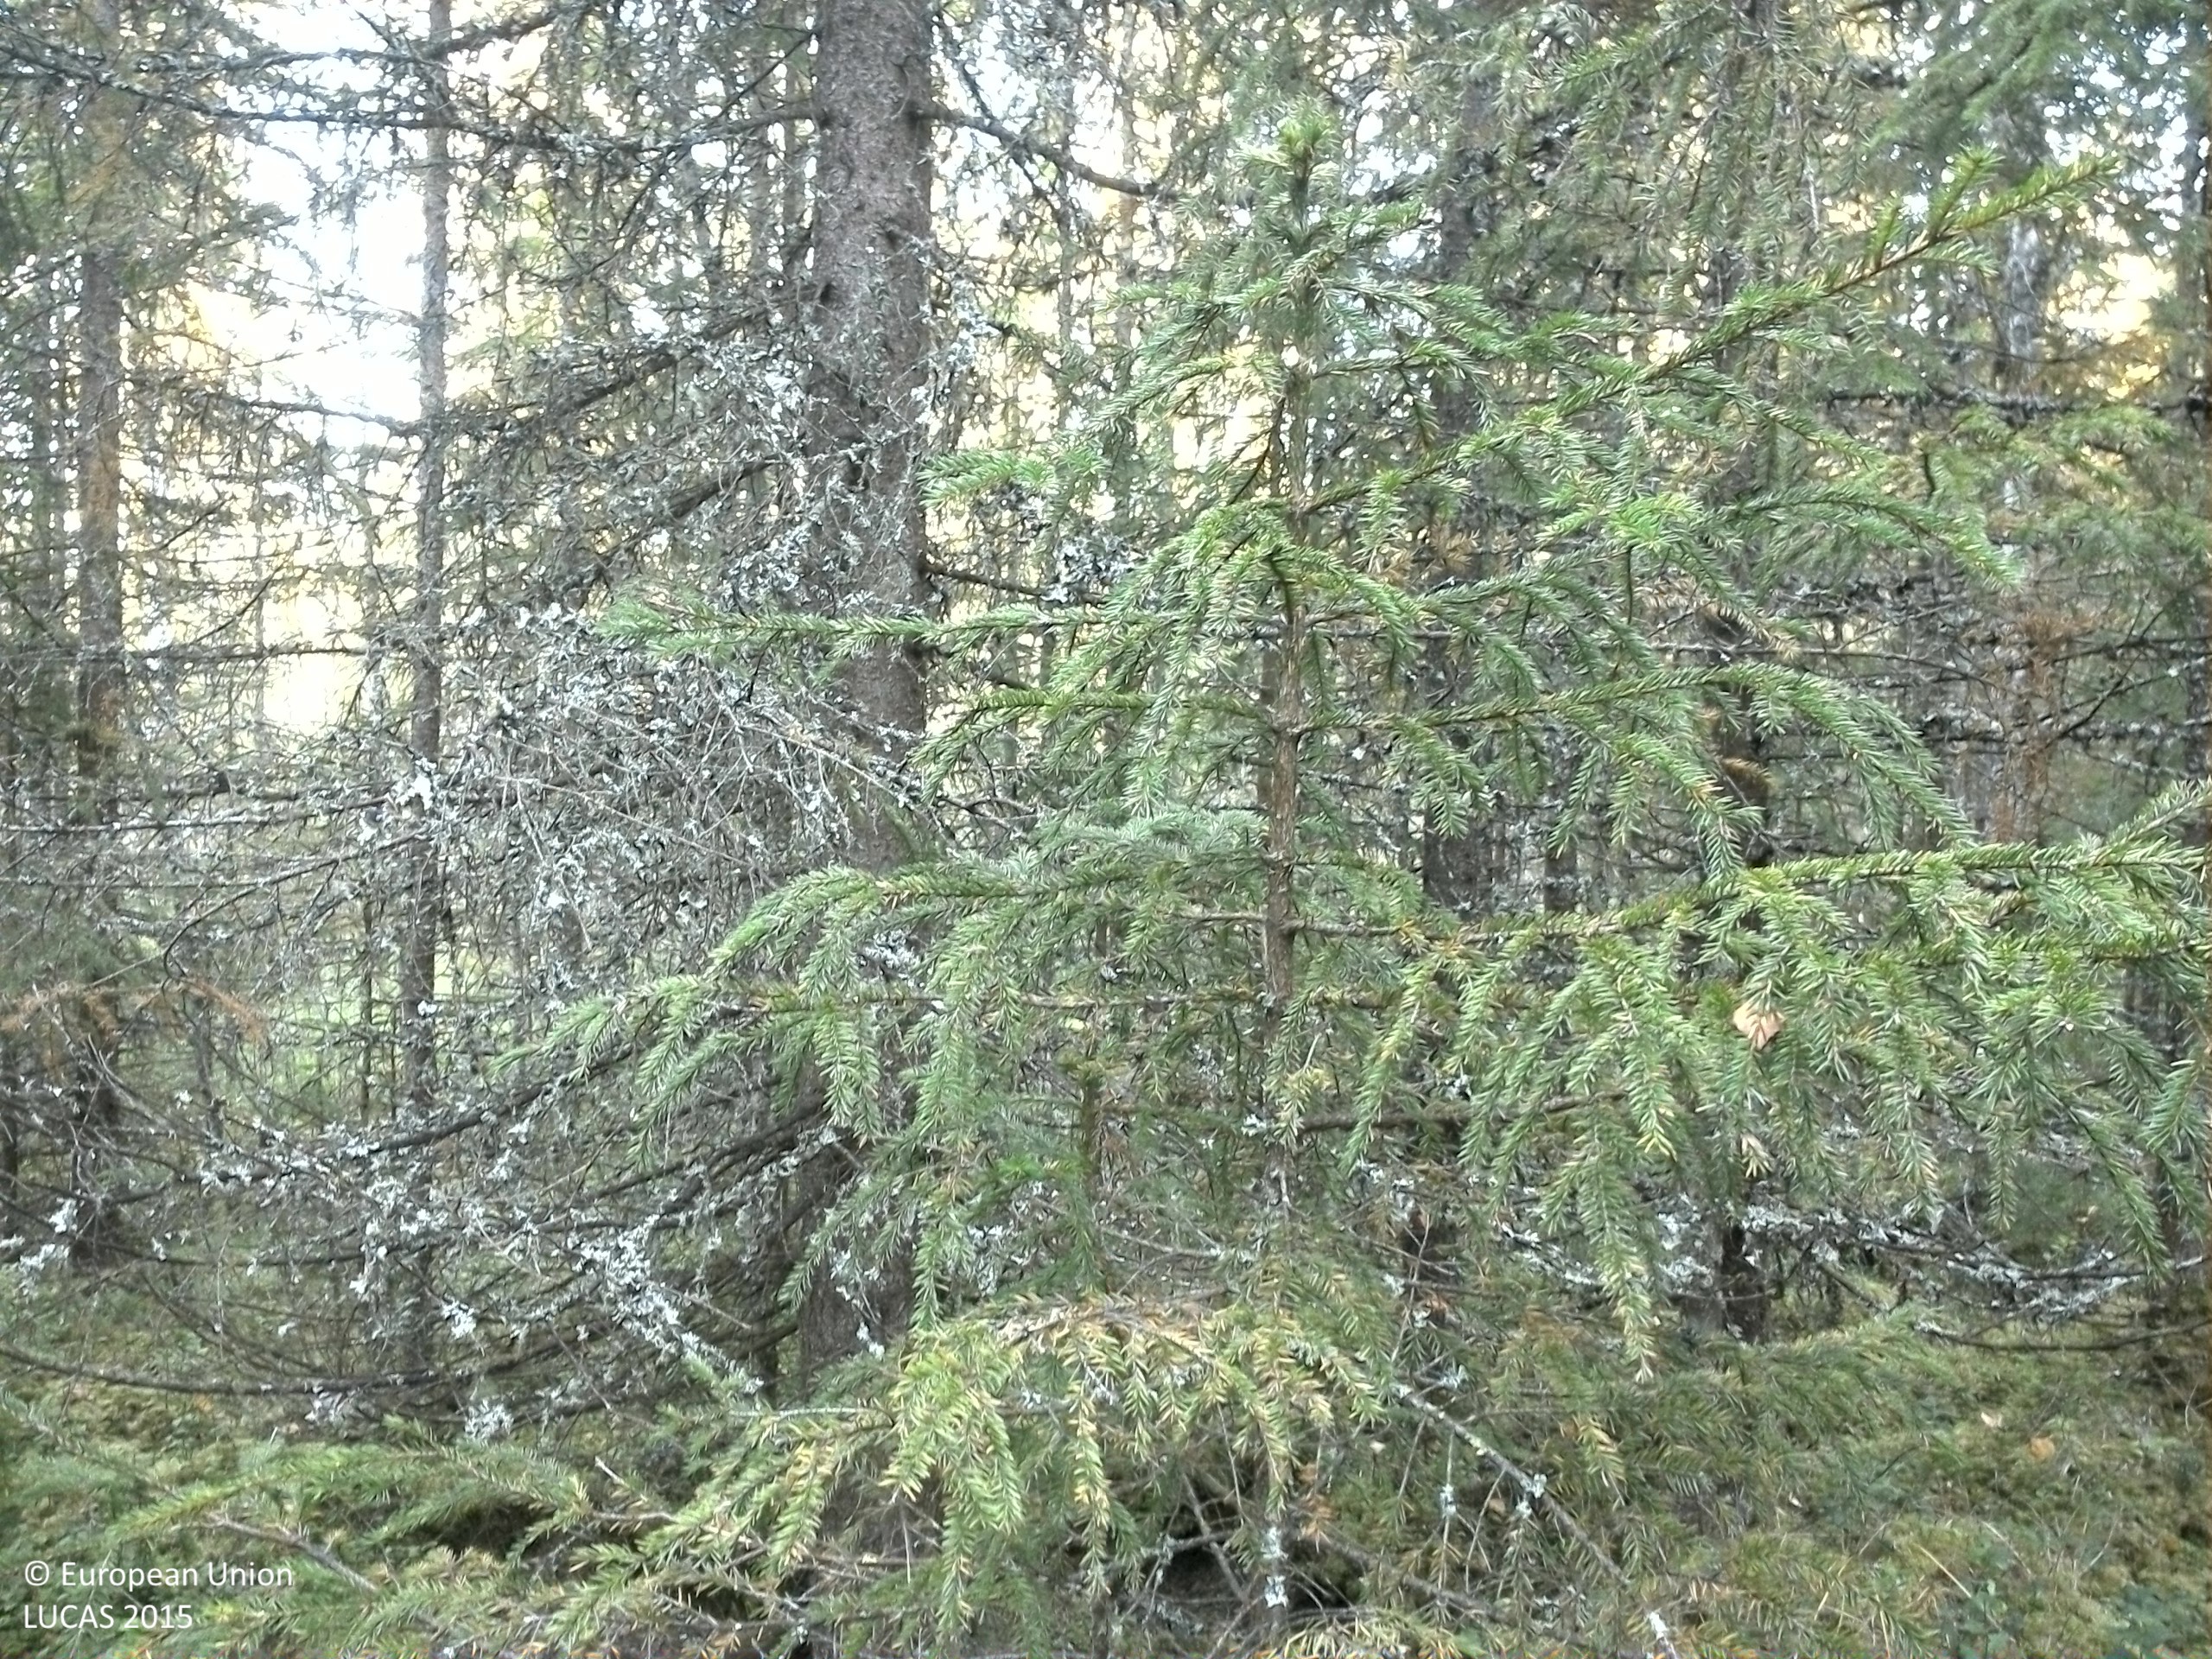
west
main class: Woodland
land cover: Spruce dominated coniferous woodland
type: boreal forest
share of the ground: 50 - 75 %
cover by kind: coniferous forest trees 70 %, shrubs 15 %, lichens and mosses 10 %, broadleaved forest trees 5 %
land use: Forestry
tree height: > 5 m
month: September
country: SE
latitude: 59.9036
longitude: 13.4773
